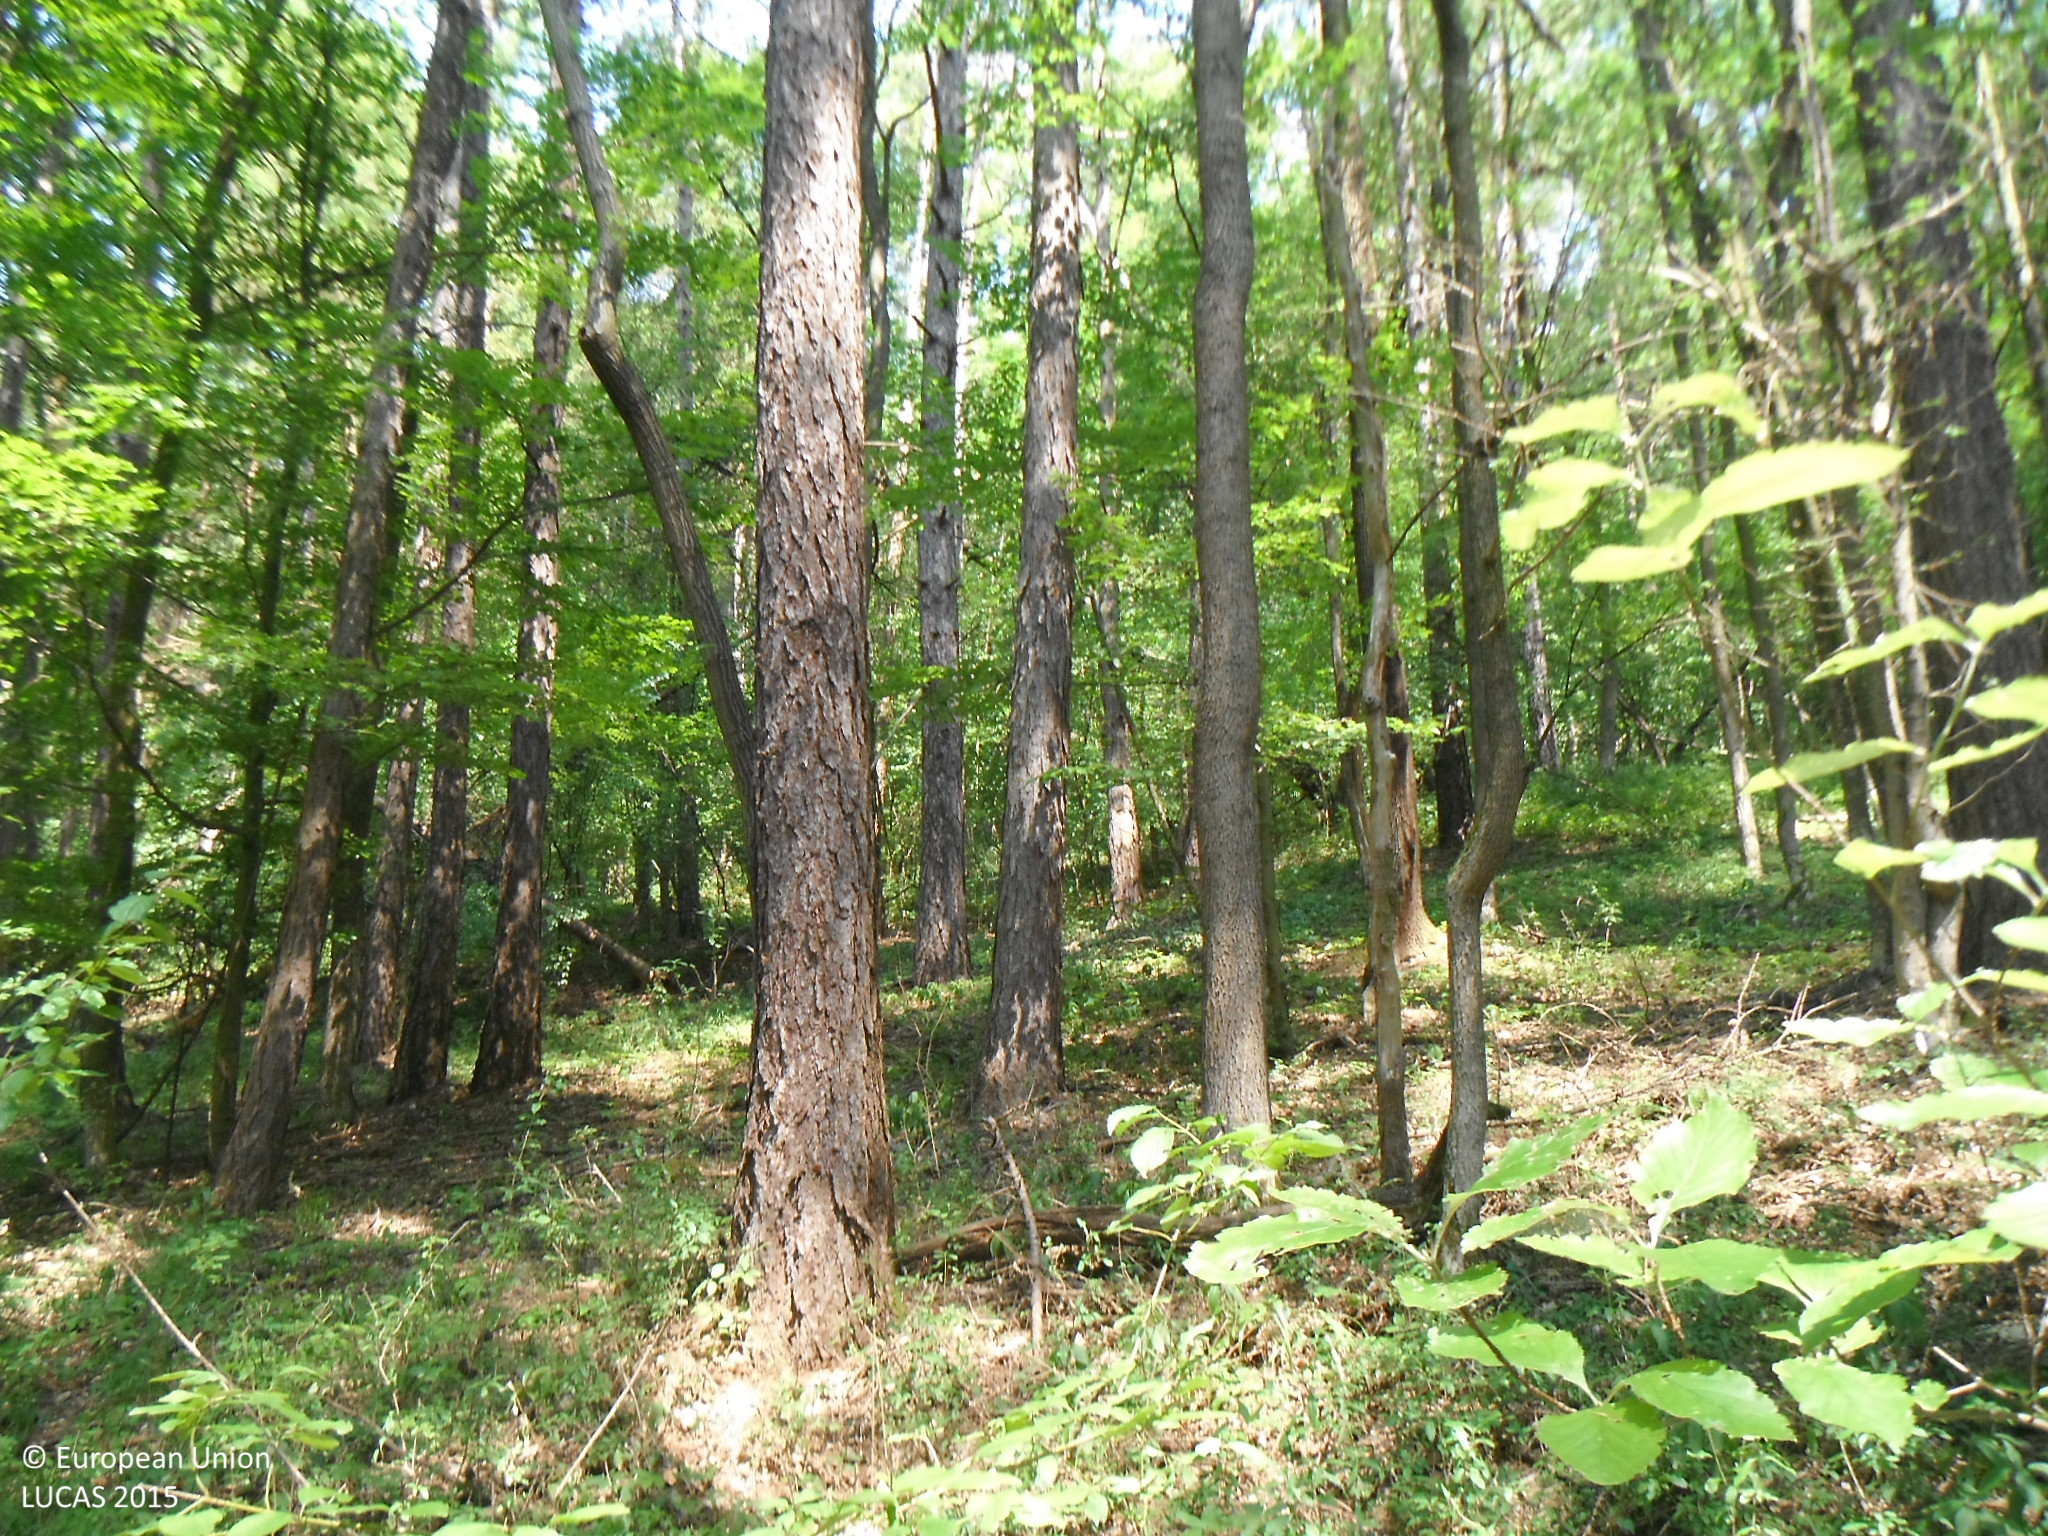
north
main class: Woodland
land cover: Other mixed woodland
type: hemiboreal forest and nemoral coniferous forest and mixed broadleaved-coniferous forest
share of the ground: > 75 %
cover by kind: coniferous forest trees 45 %, broadleaved forest trees 45 %, shrubs 5 %, herbaceous plants 5 %
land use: Forestry
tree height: > 5 m
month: July
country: SK
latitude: 48.6872
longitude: 17.5503
